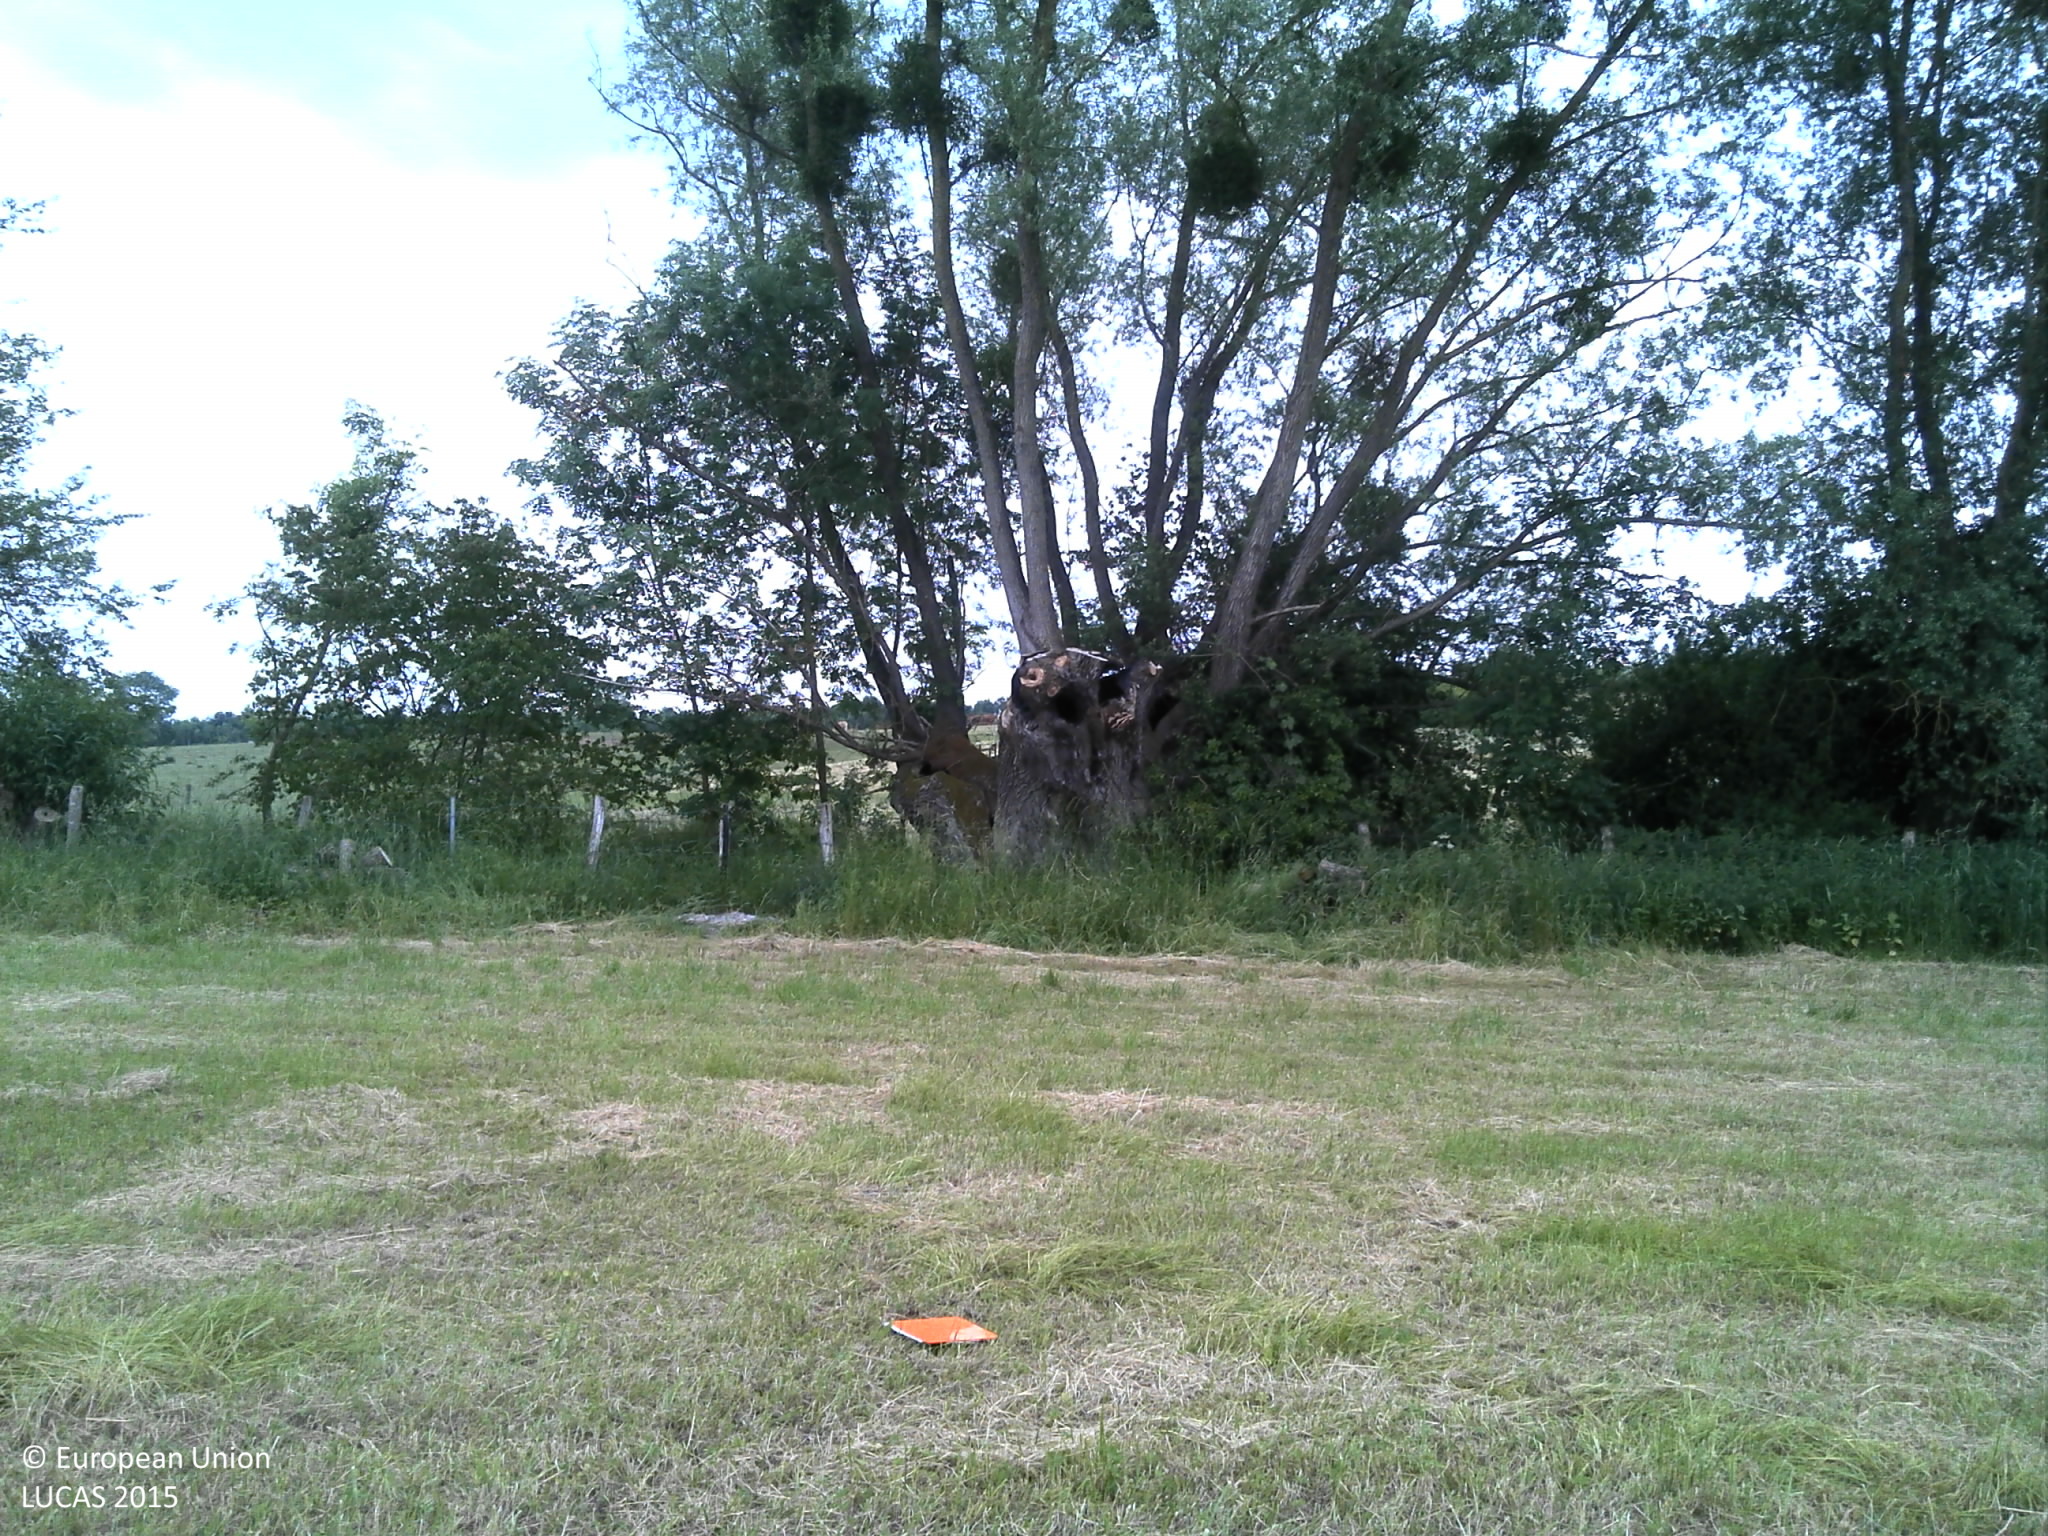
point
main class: Grassland
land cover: Grassland without tree/shrub cover
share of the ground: > 75 %
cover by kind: herbaceous plants 100 %
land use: Agriculture (excluding fallow land and kitchen gardens)
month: June
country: FR
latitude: 49.2404
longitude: 6.2500
